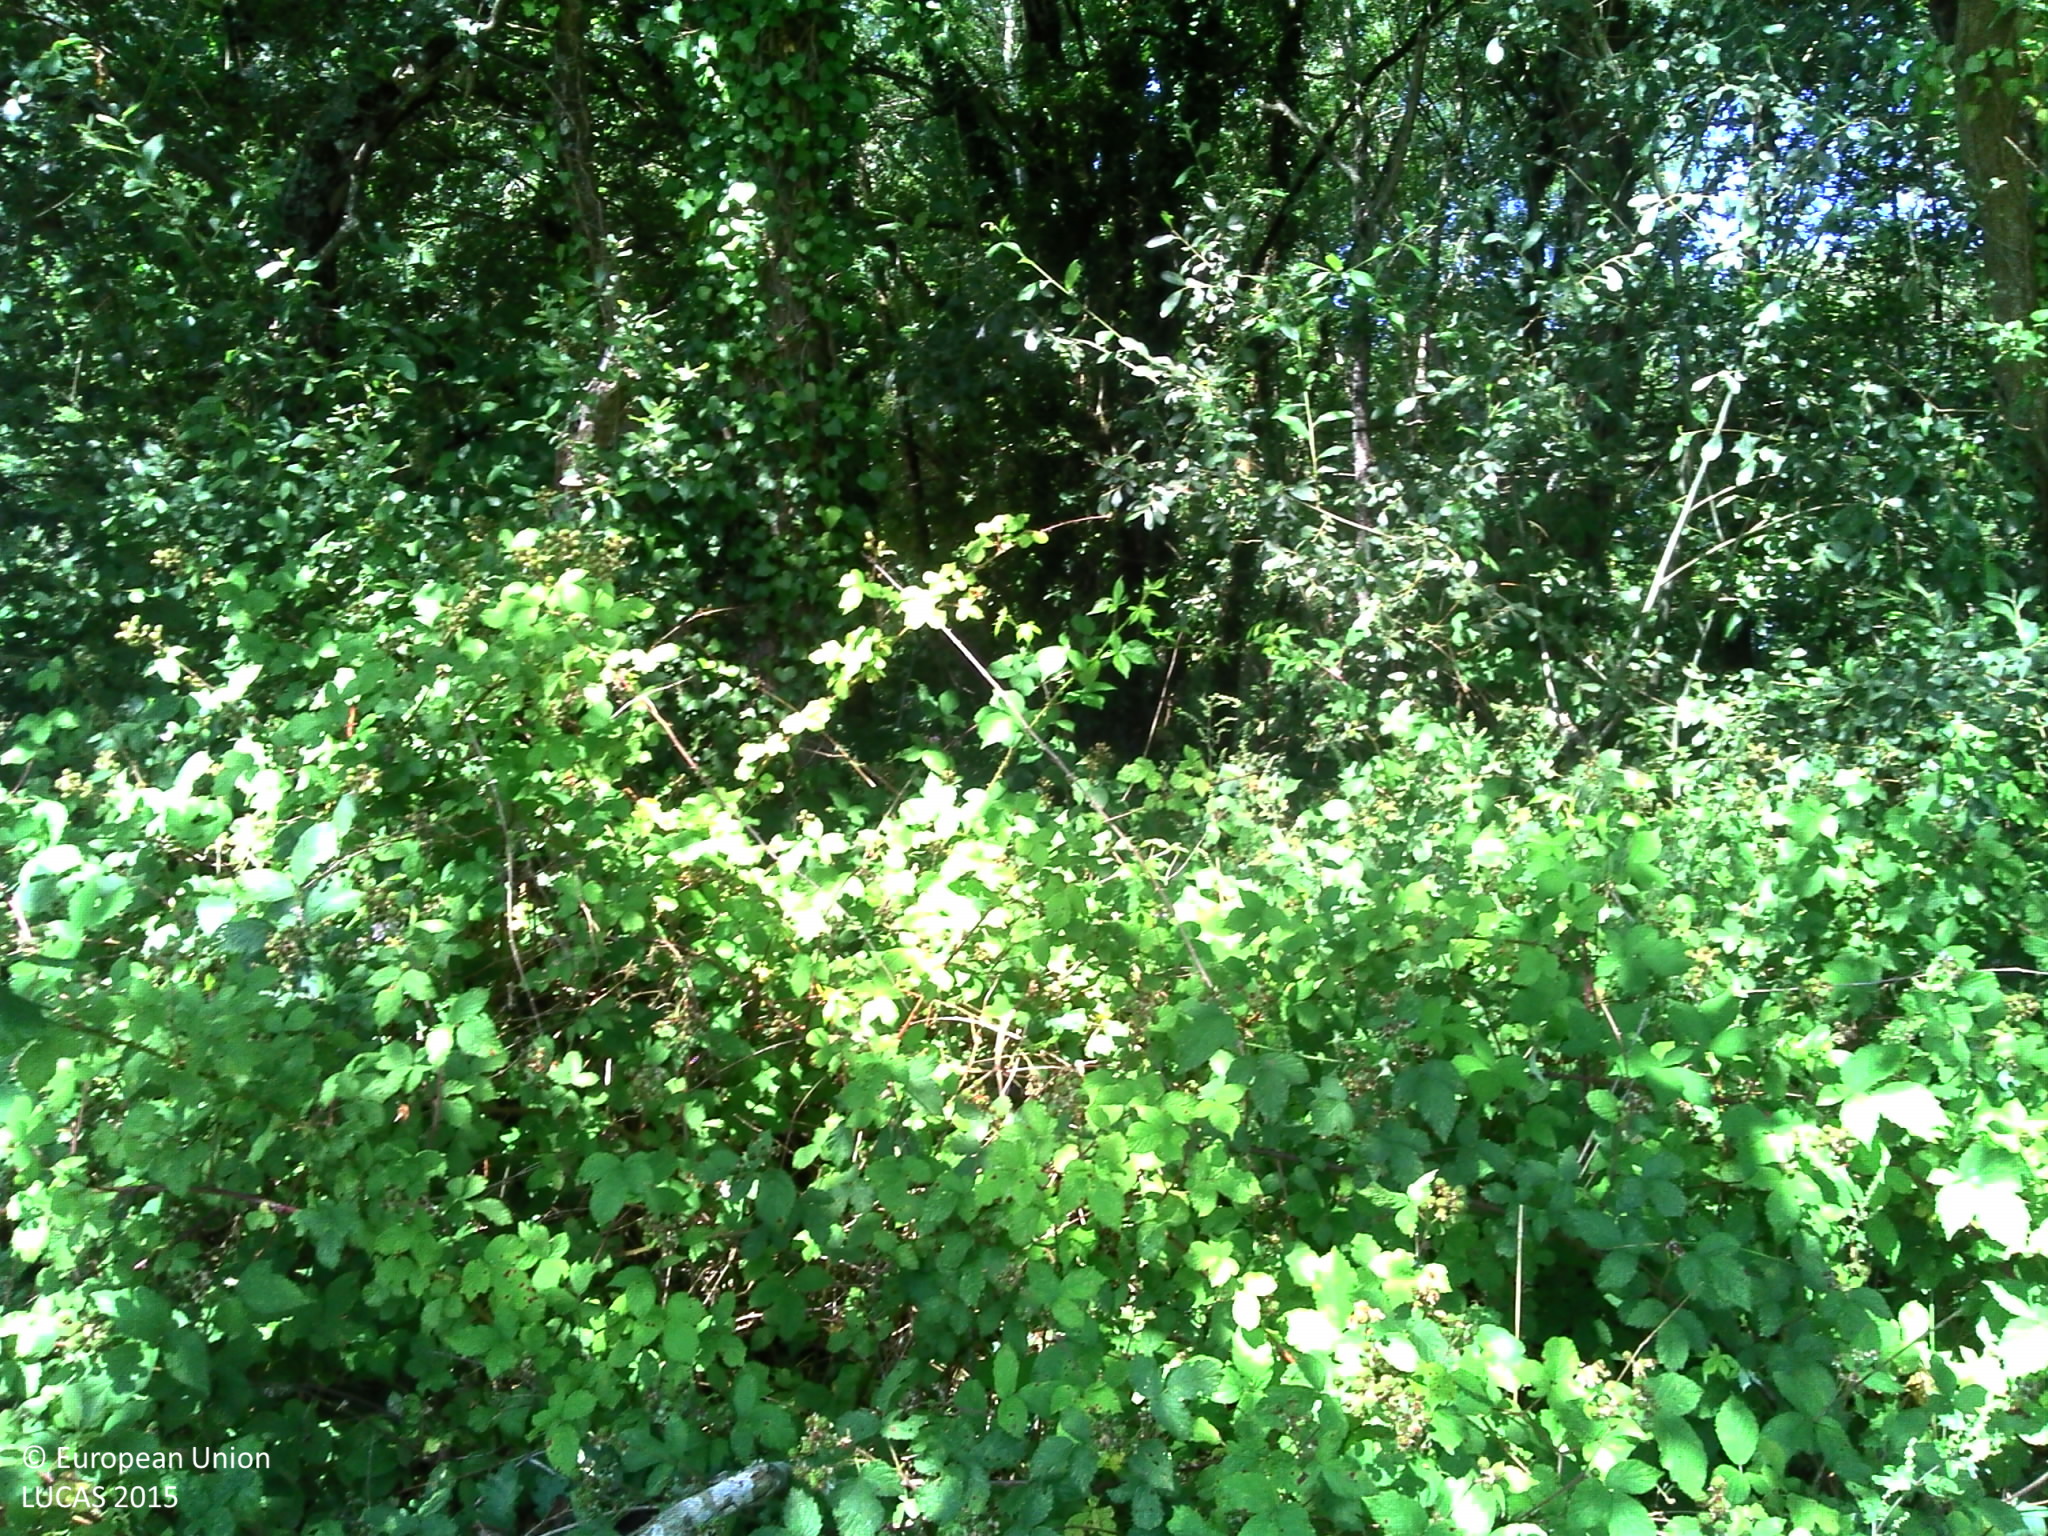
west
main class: Grassland
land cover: Grassland without tree/shrub cover
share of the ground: > 75 %
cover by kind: herbaceous plants 100 %
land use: Agriculture (excluding fallow land and kitchen gardens)
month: July
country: FR
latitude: 47.7250
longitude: -2.0368
